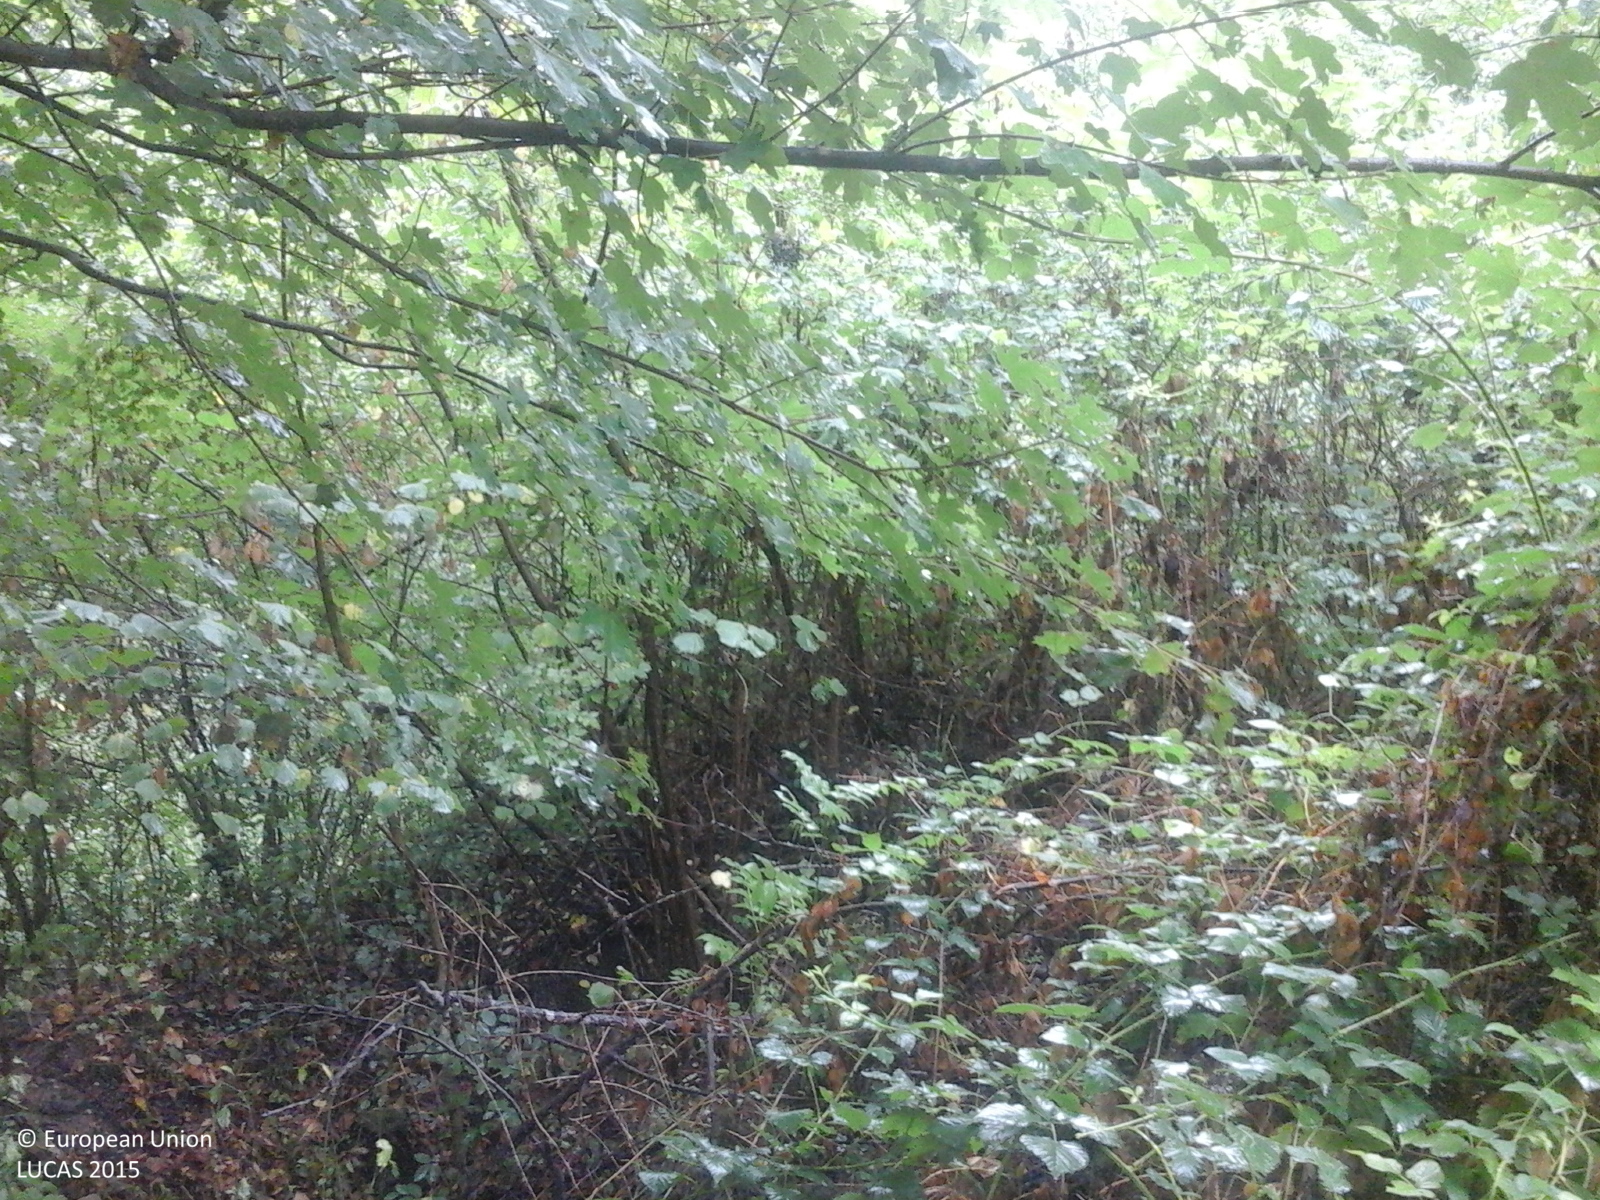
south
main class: Woodland
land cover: Broadleaved woodland
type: mesophytic deciduous forest
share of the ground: > 75 %
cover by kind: broadleaved forest trees 100 %
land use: Forestry
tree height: > 5 m
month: August
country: RO
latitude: 44.9288
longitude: 22.1366
